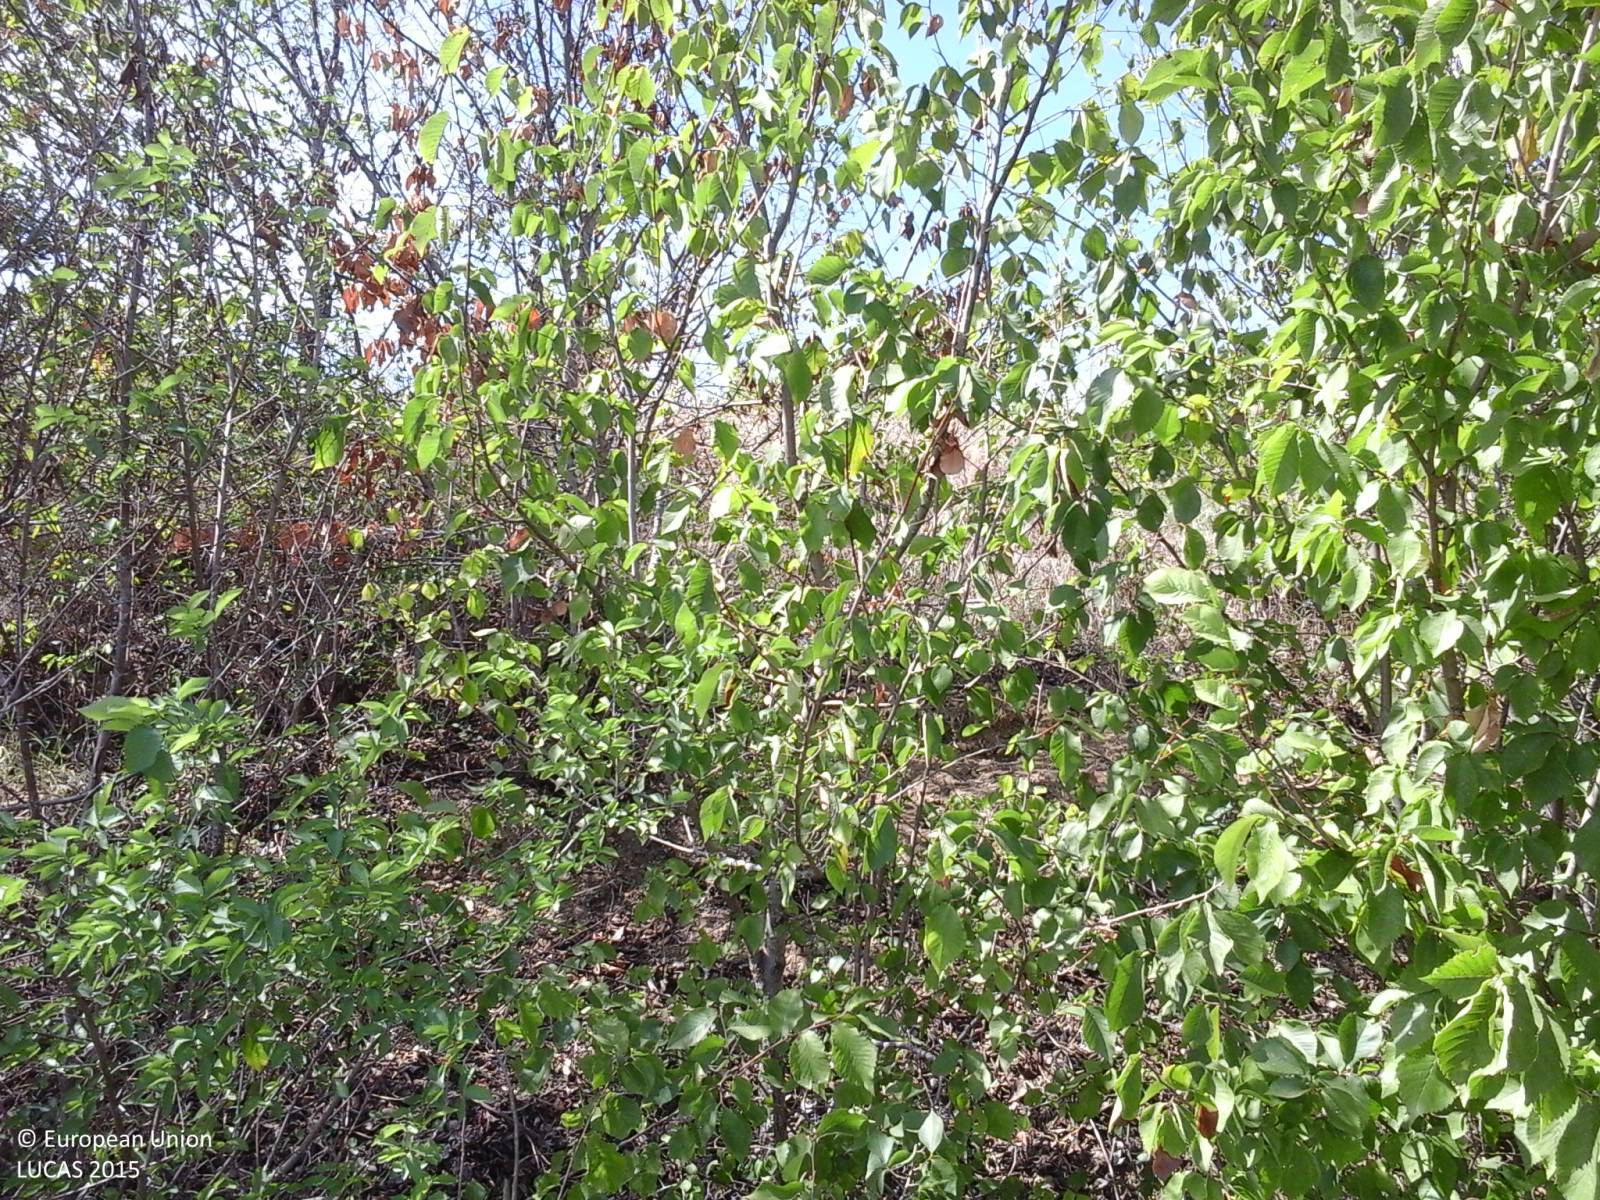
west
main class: Grassland
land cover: Grassland without tree/shrub cover
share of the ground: 25 - 50 %
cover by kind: herbaceous plants 100 %
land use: Agriculture (excluding fallow land and kitchen gardens)
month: September
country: IT
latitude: 42.9878
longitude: 12.3600
